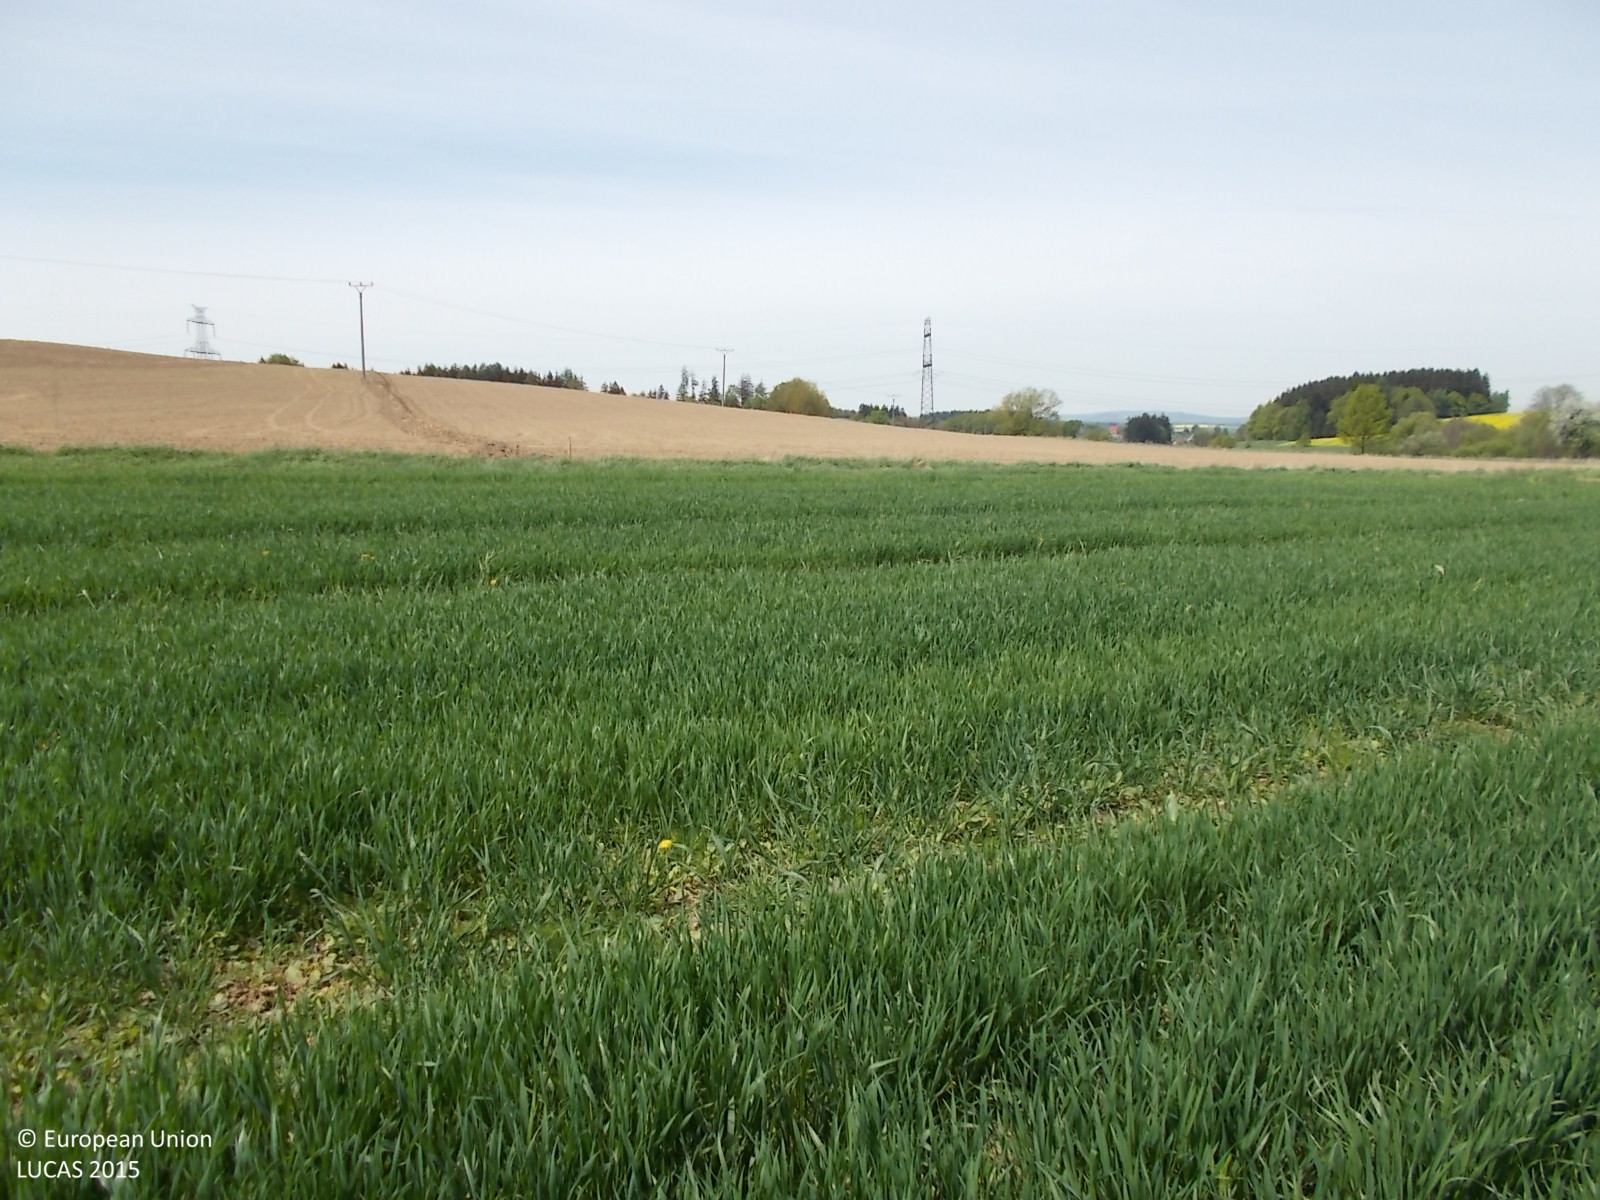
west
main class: Cropland
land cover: Common wheat
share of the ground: > 75 %
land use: Agriculture (excluding fallow land and kitchen gardens)
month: May
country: CZ
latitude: 49.5598
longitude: 15.6031
